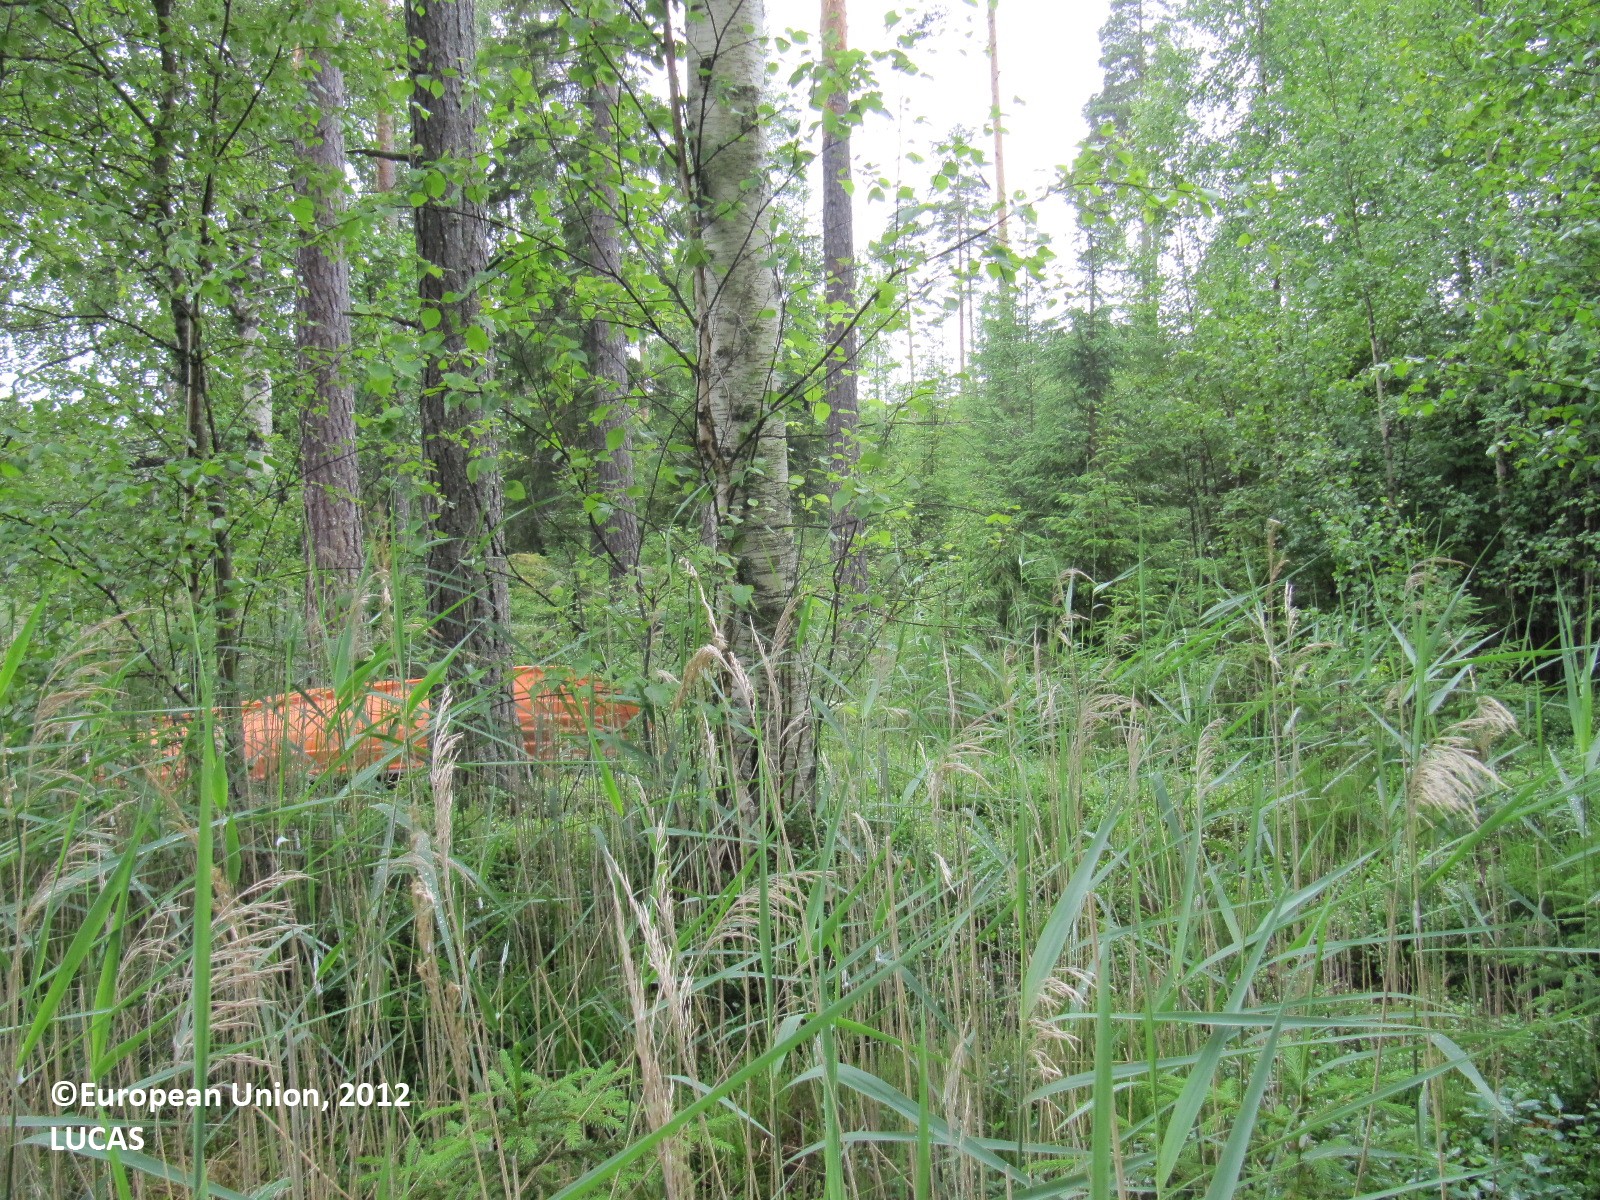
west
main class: Woodland
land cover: Other mixed woodland
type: boreal forest
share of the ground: > 75 %
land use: Forestry
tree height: > 5 m
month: July
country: FI
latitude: 60.9273
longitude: 24.1727
